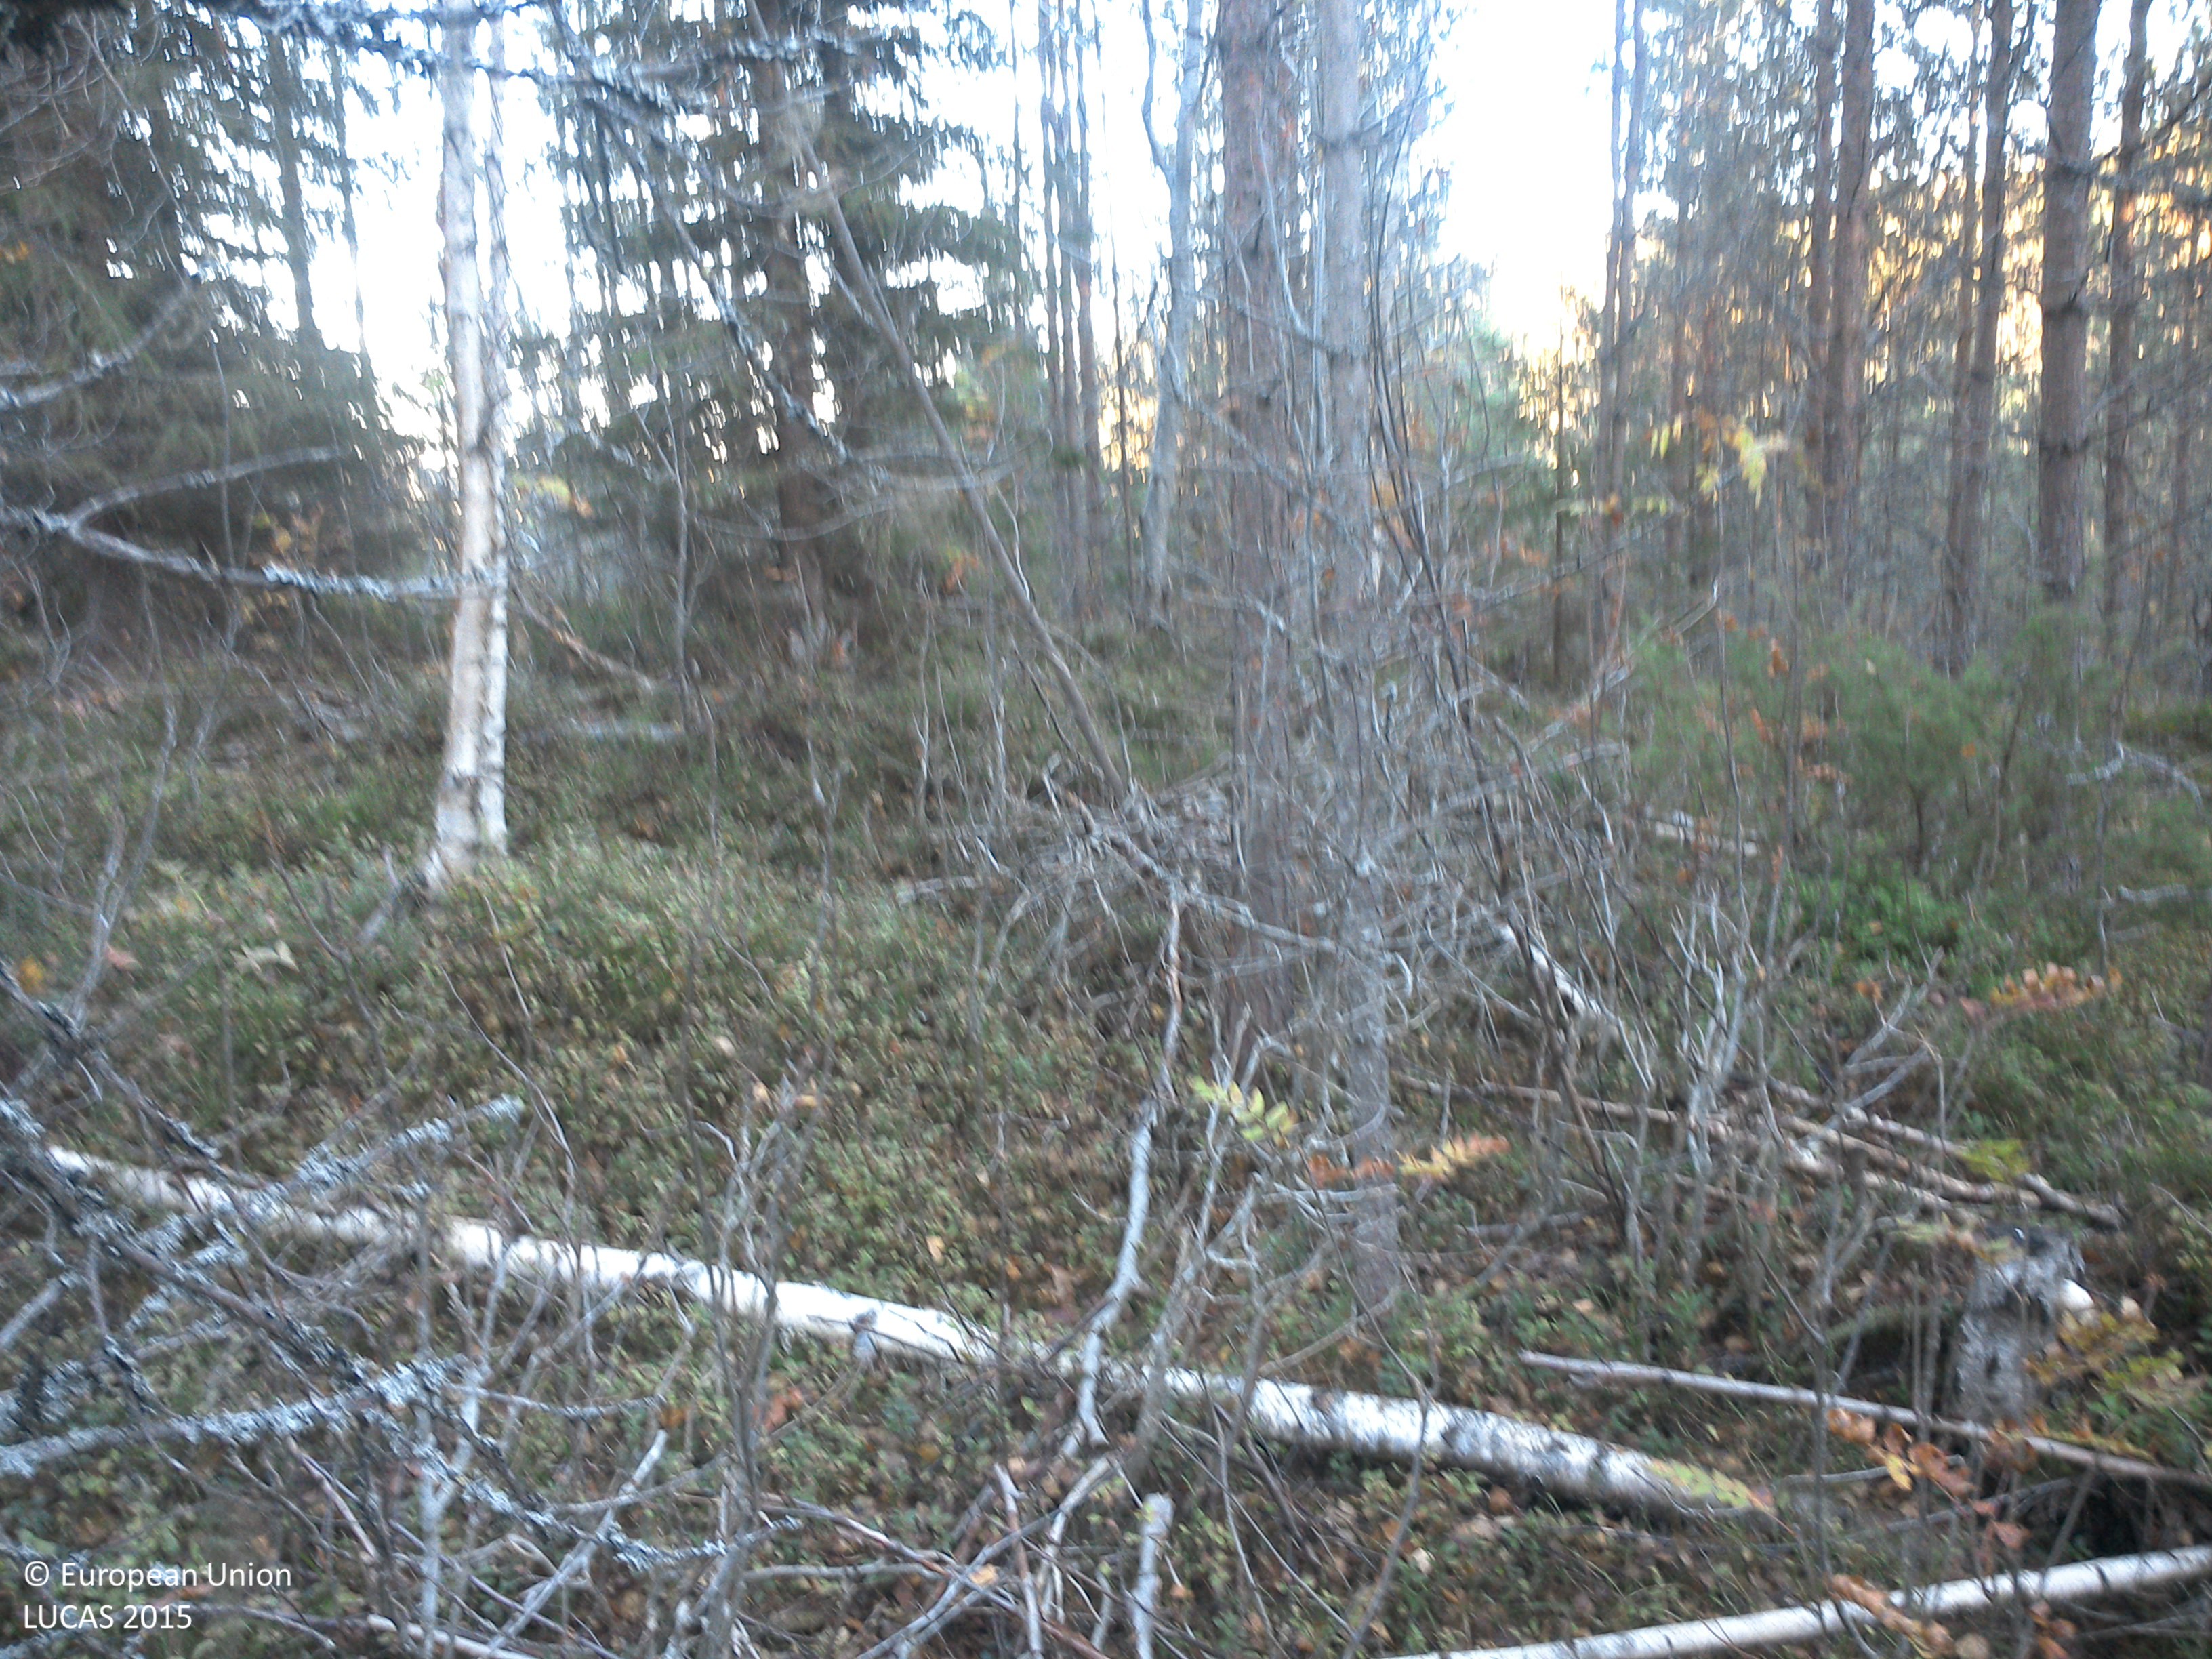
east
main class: Woodland
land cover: Other mixed woodland
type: boreal forest
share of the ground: 50 - 75 %
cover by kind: shrubs 45 %, coniferous forest trees 30 %, broadleaved forest trees 25 %
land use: Forestry
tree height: > 5 m
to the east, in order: Other mixed woodland; Broadleaved woodland; Rivers and streams; Shrubland without tree cover; Paved roads, cycling and walking lanes; Ditches and canals; Spruce dominated mixed woodland; Other mixed woodland; Pine dominated coniferous woodland; Spruce dominated mixed woodland
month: October
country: SE
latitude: 63.8931
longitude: 19.8163
